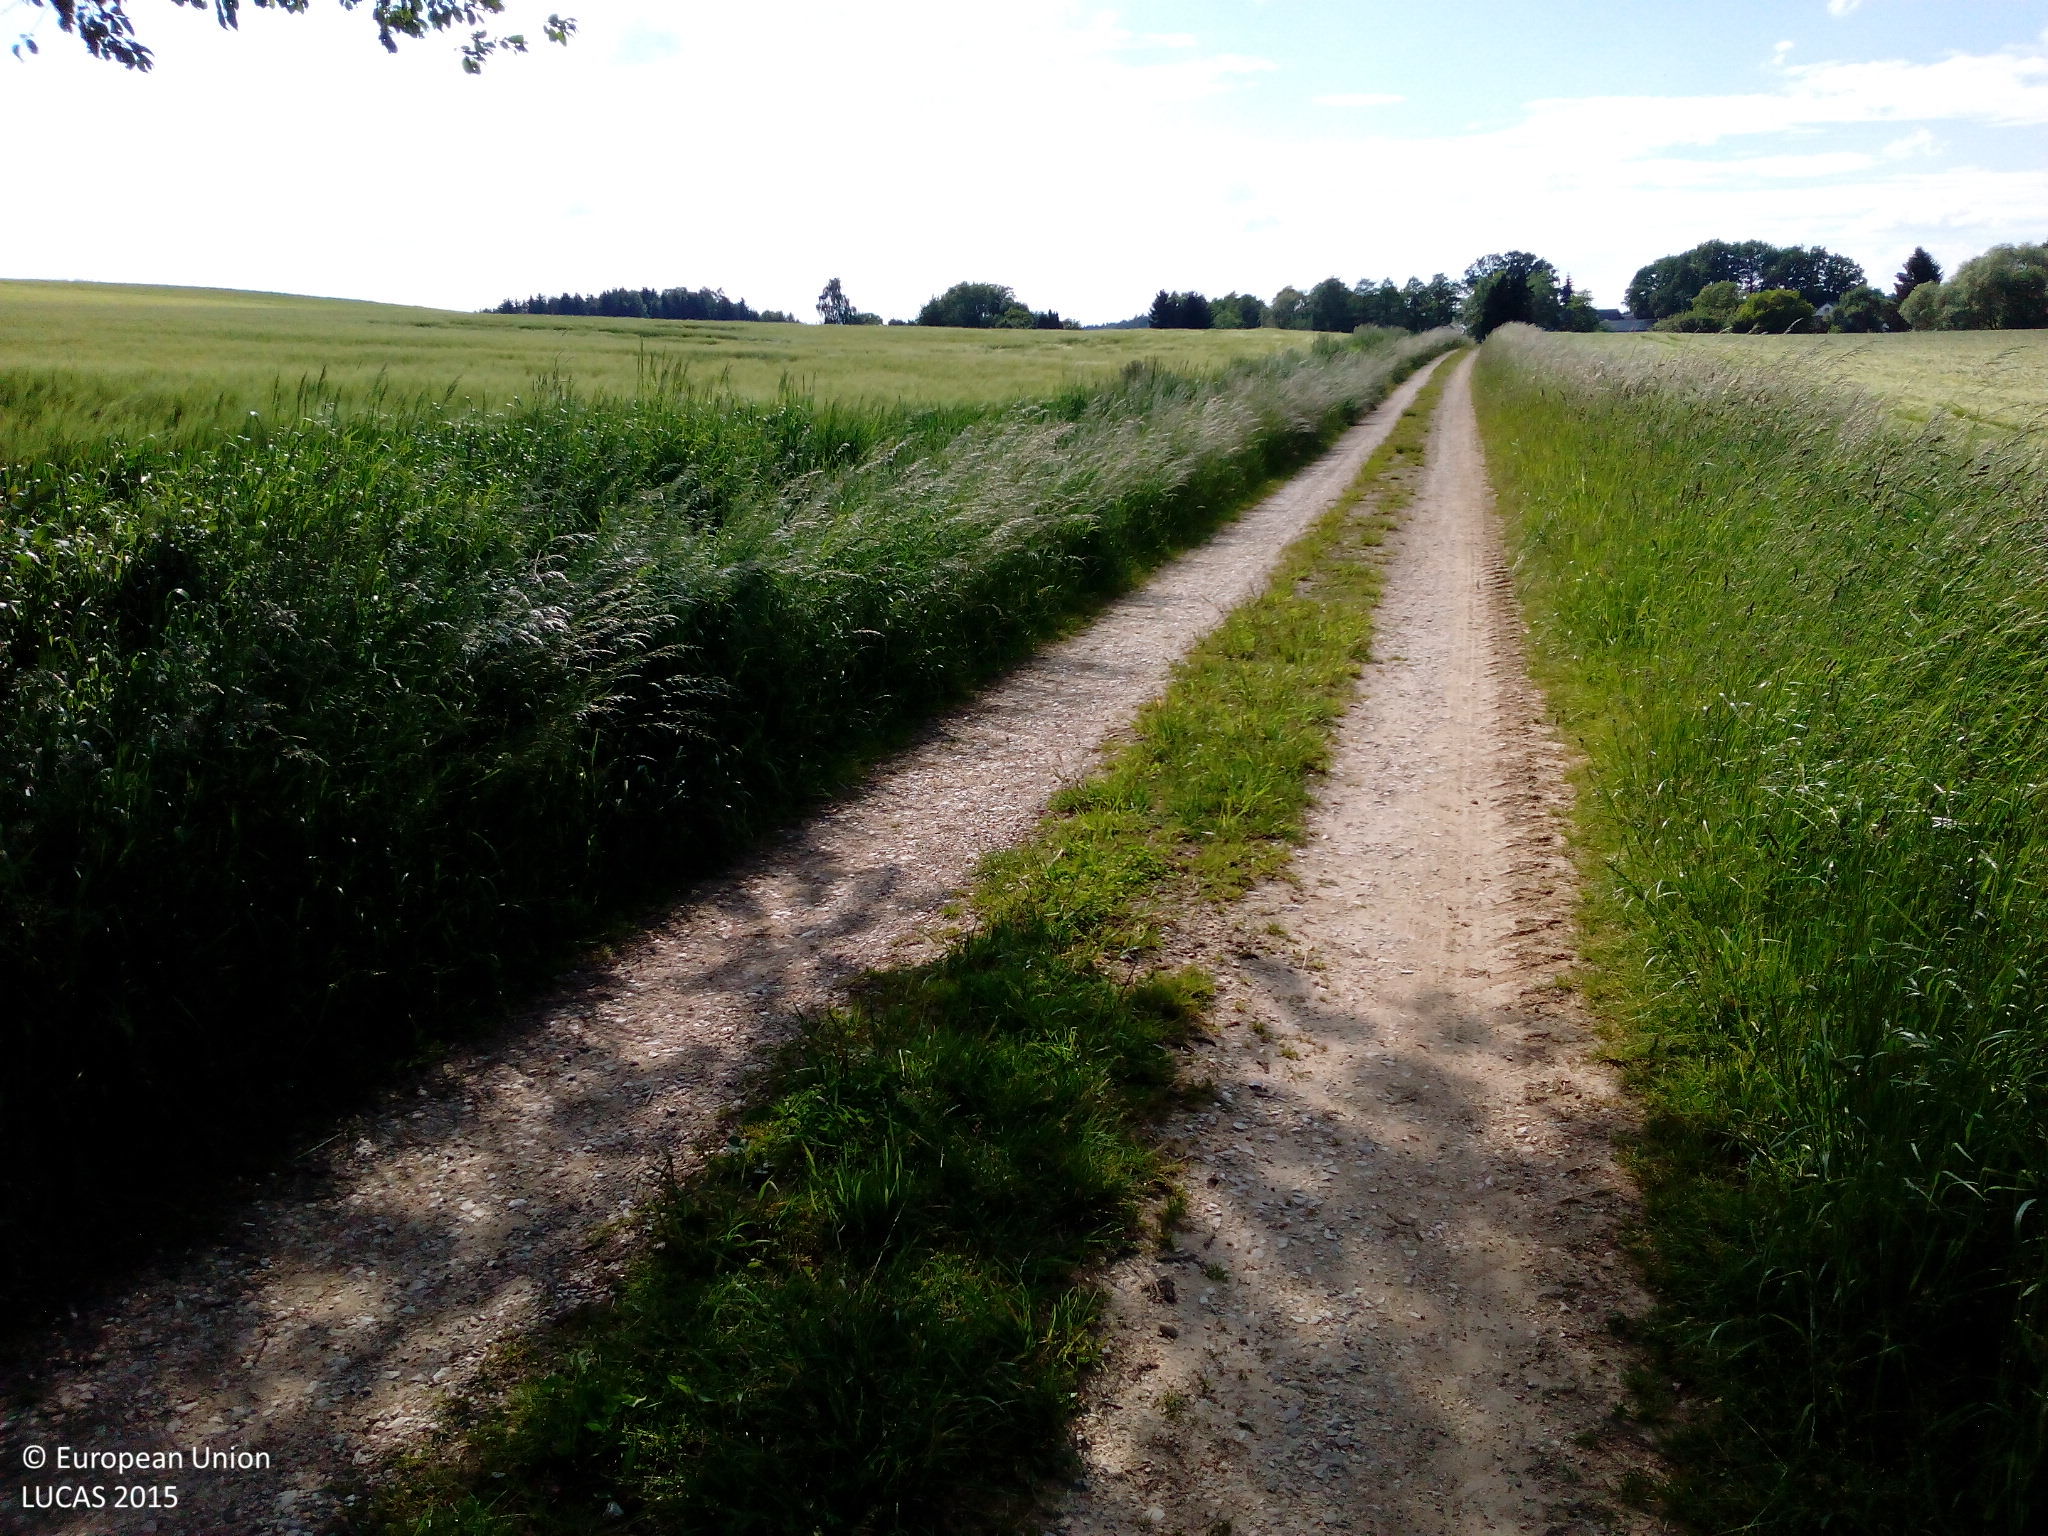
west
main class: Cropland
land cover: Rye
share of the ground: > 75 %
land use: Agriculture (excluding fallow land and kitchen gardens)
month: June
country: DE
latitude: 48.7439
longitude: 12.0799
